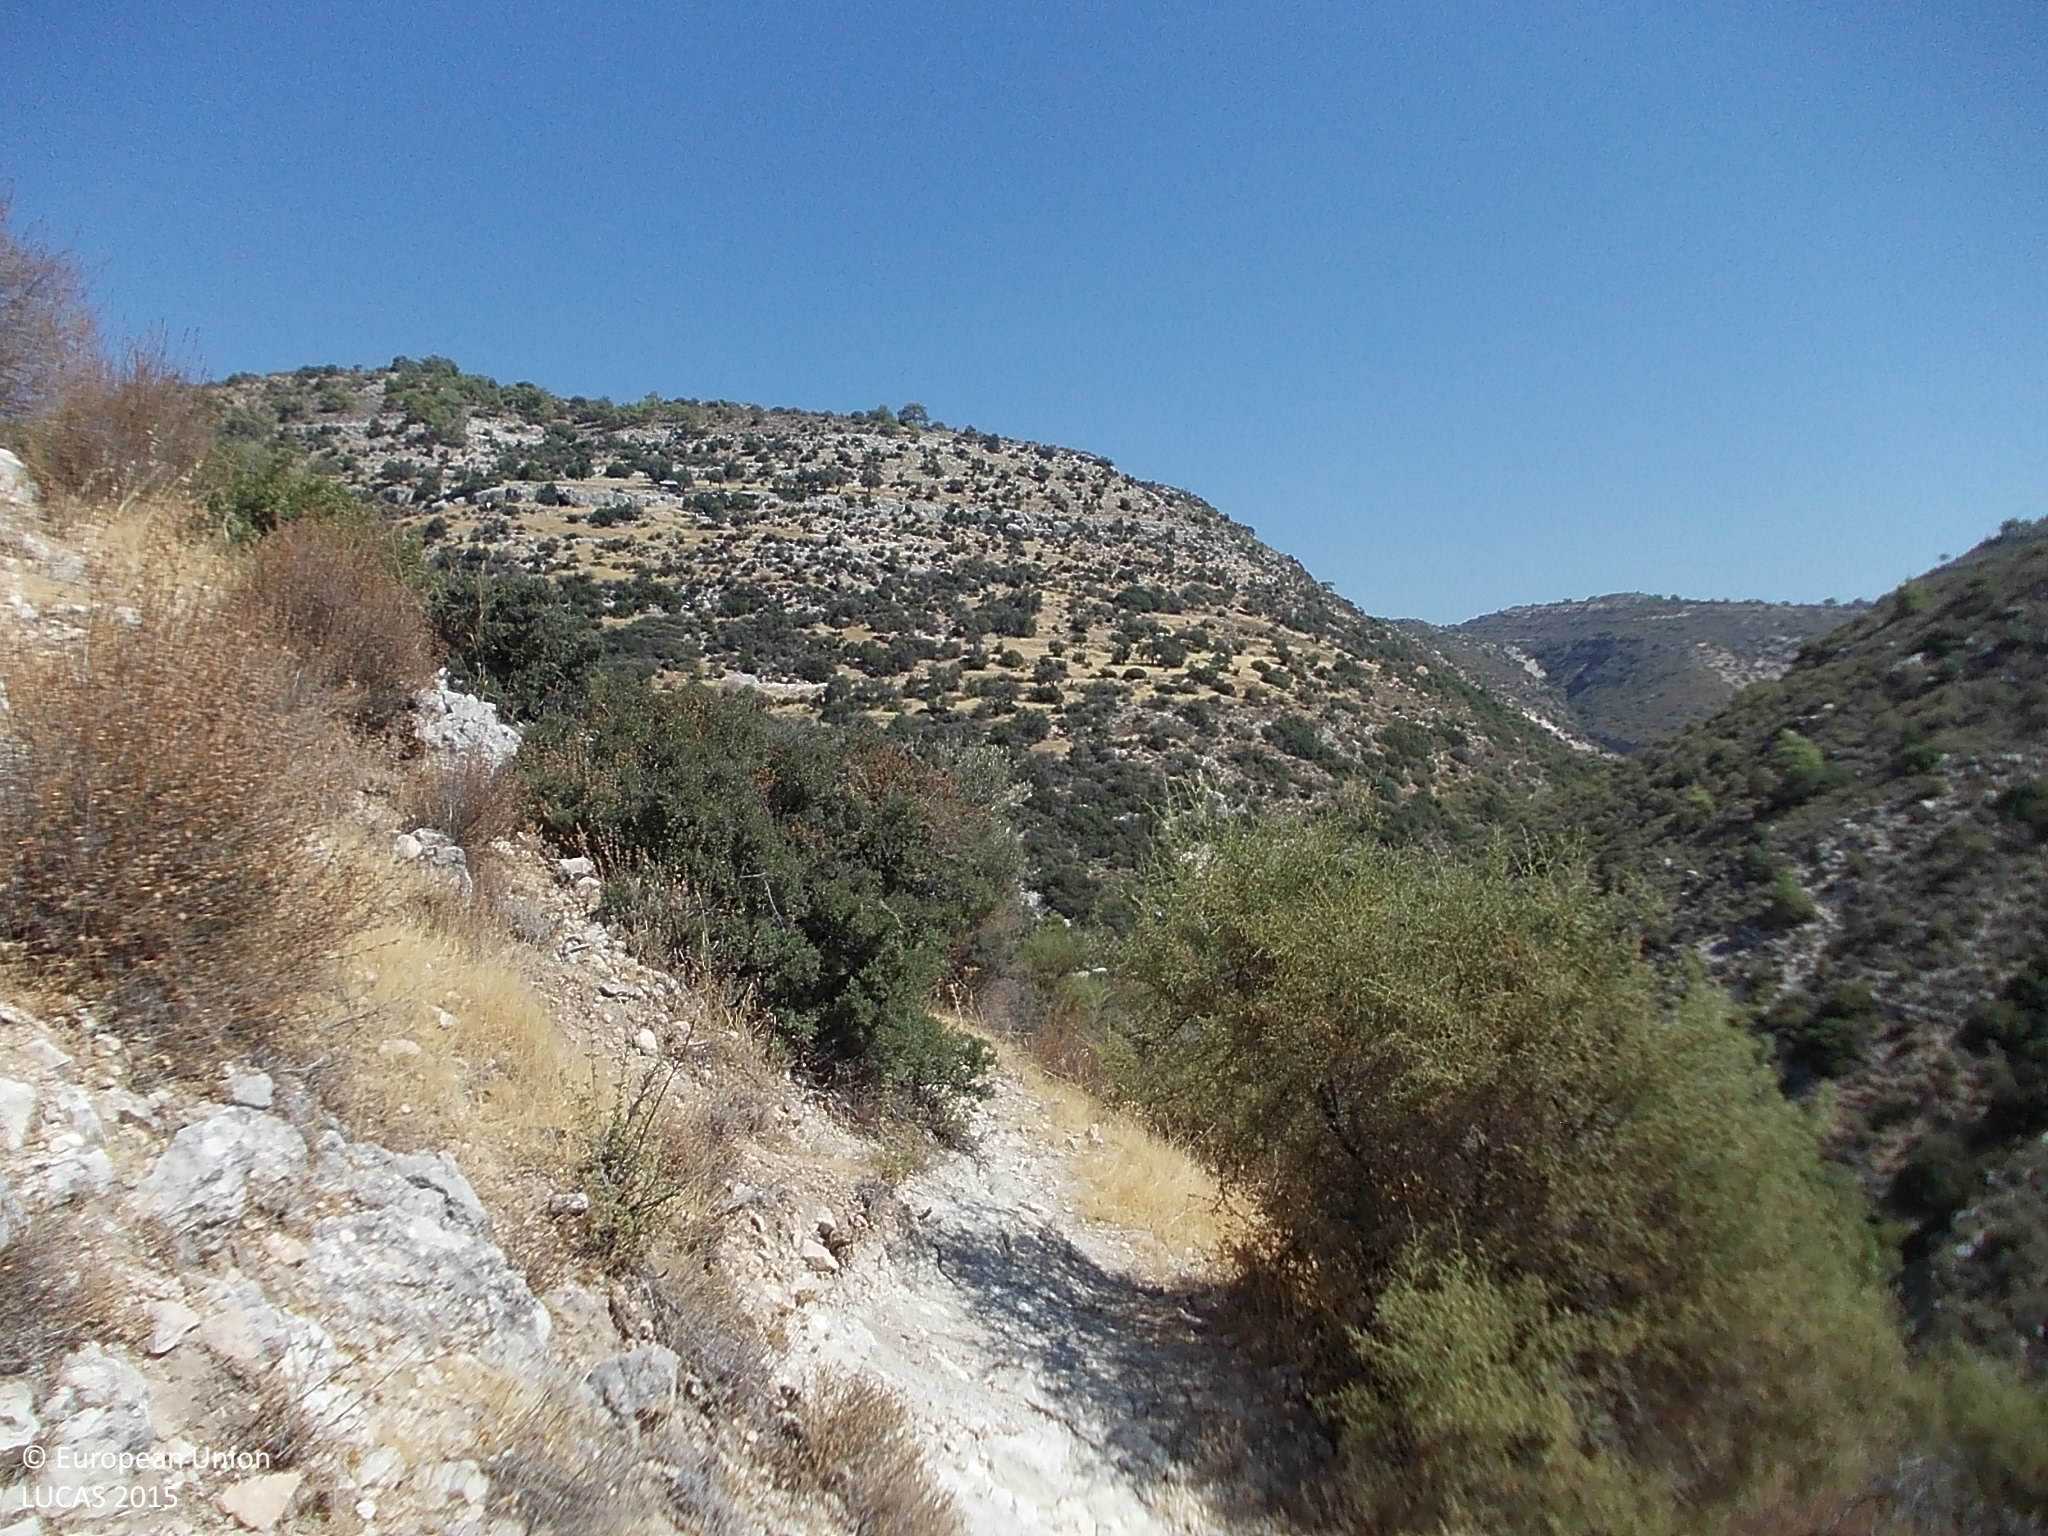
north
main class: Shrubland
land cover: Shrubland without tree cover
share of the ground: 50 - 75 %
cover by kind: shrubs 60 %, unconsolidated bare surface 20 %, herbaceous plants 10 %, consolidated bare surface 10 %
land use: Semi-natural and natural areas not in use
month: September
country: CY
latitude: 34.7331
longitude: 32.7972
